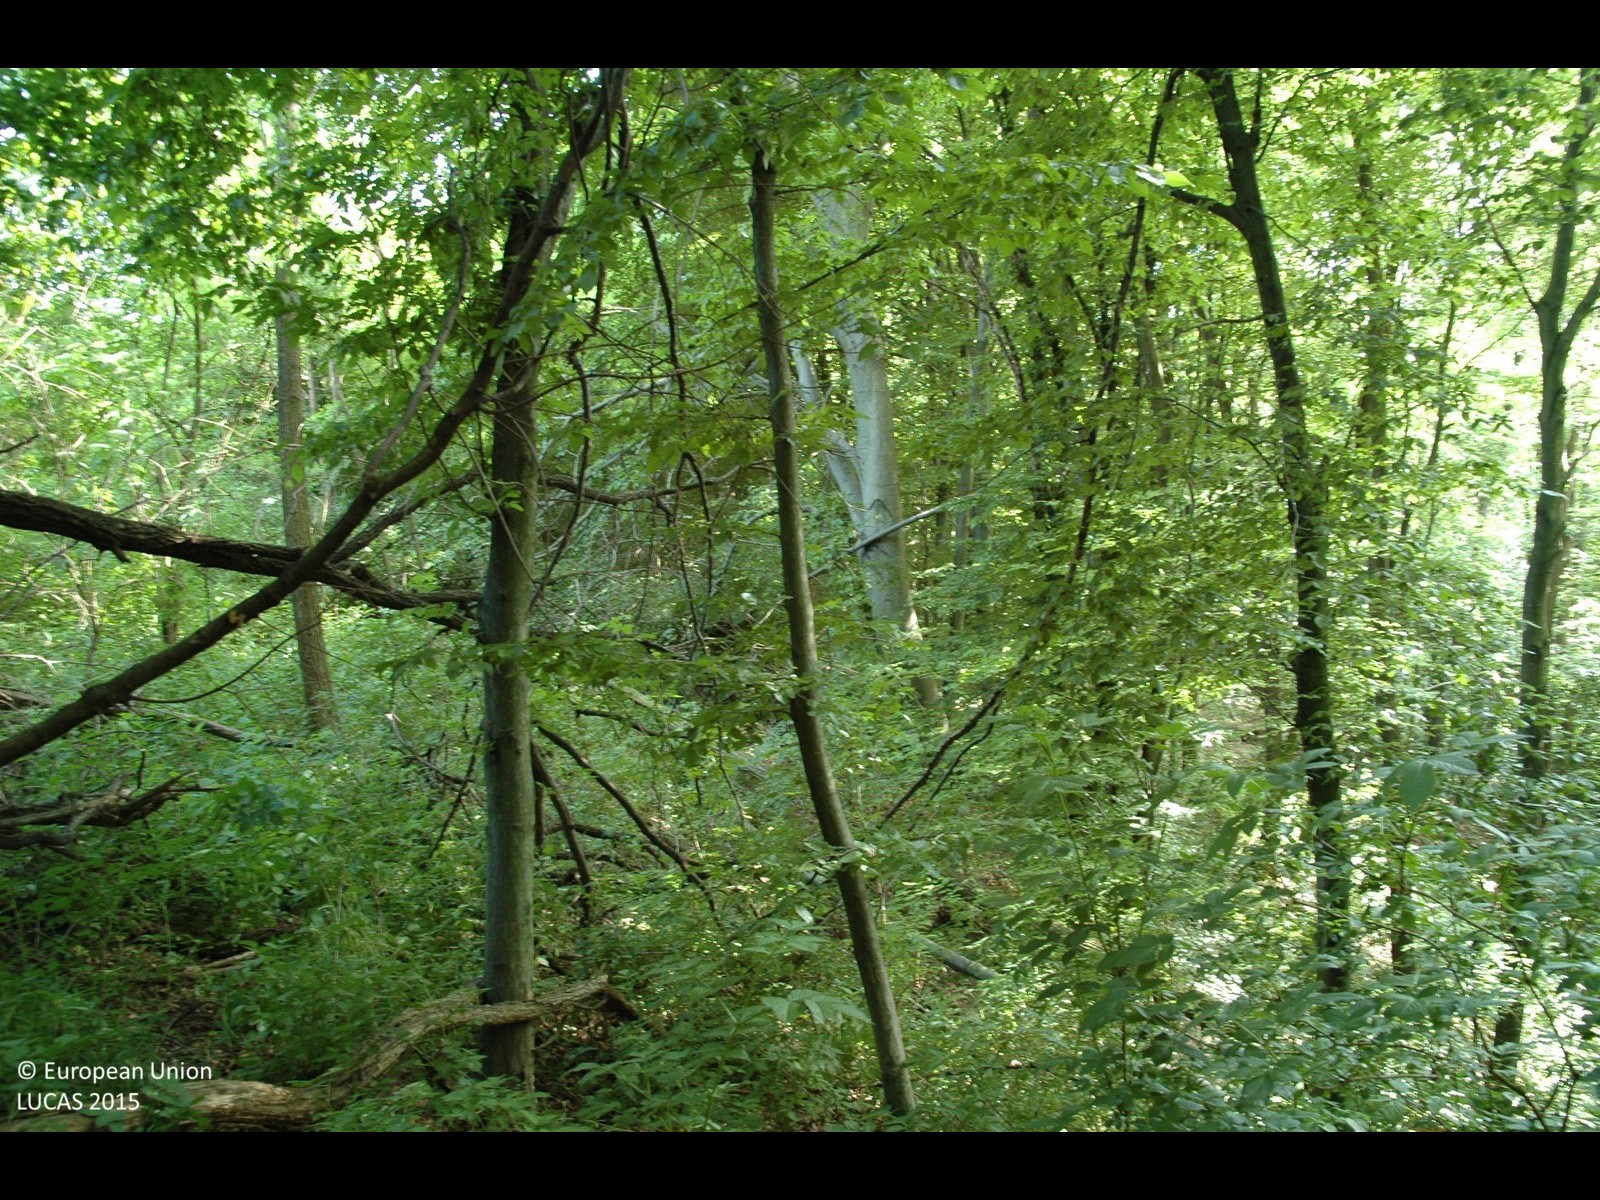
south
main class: Woodland
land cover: Broadleaved woodland
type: beech forest
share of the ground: > 75 %
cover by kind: broadleaved forest trees 90 %, shrubs 5 %, herbaceous plants 5 %
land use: Forestry
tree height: > 5 m
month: May
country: HR
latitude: 46.5105
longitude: 16.2692
